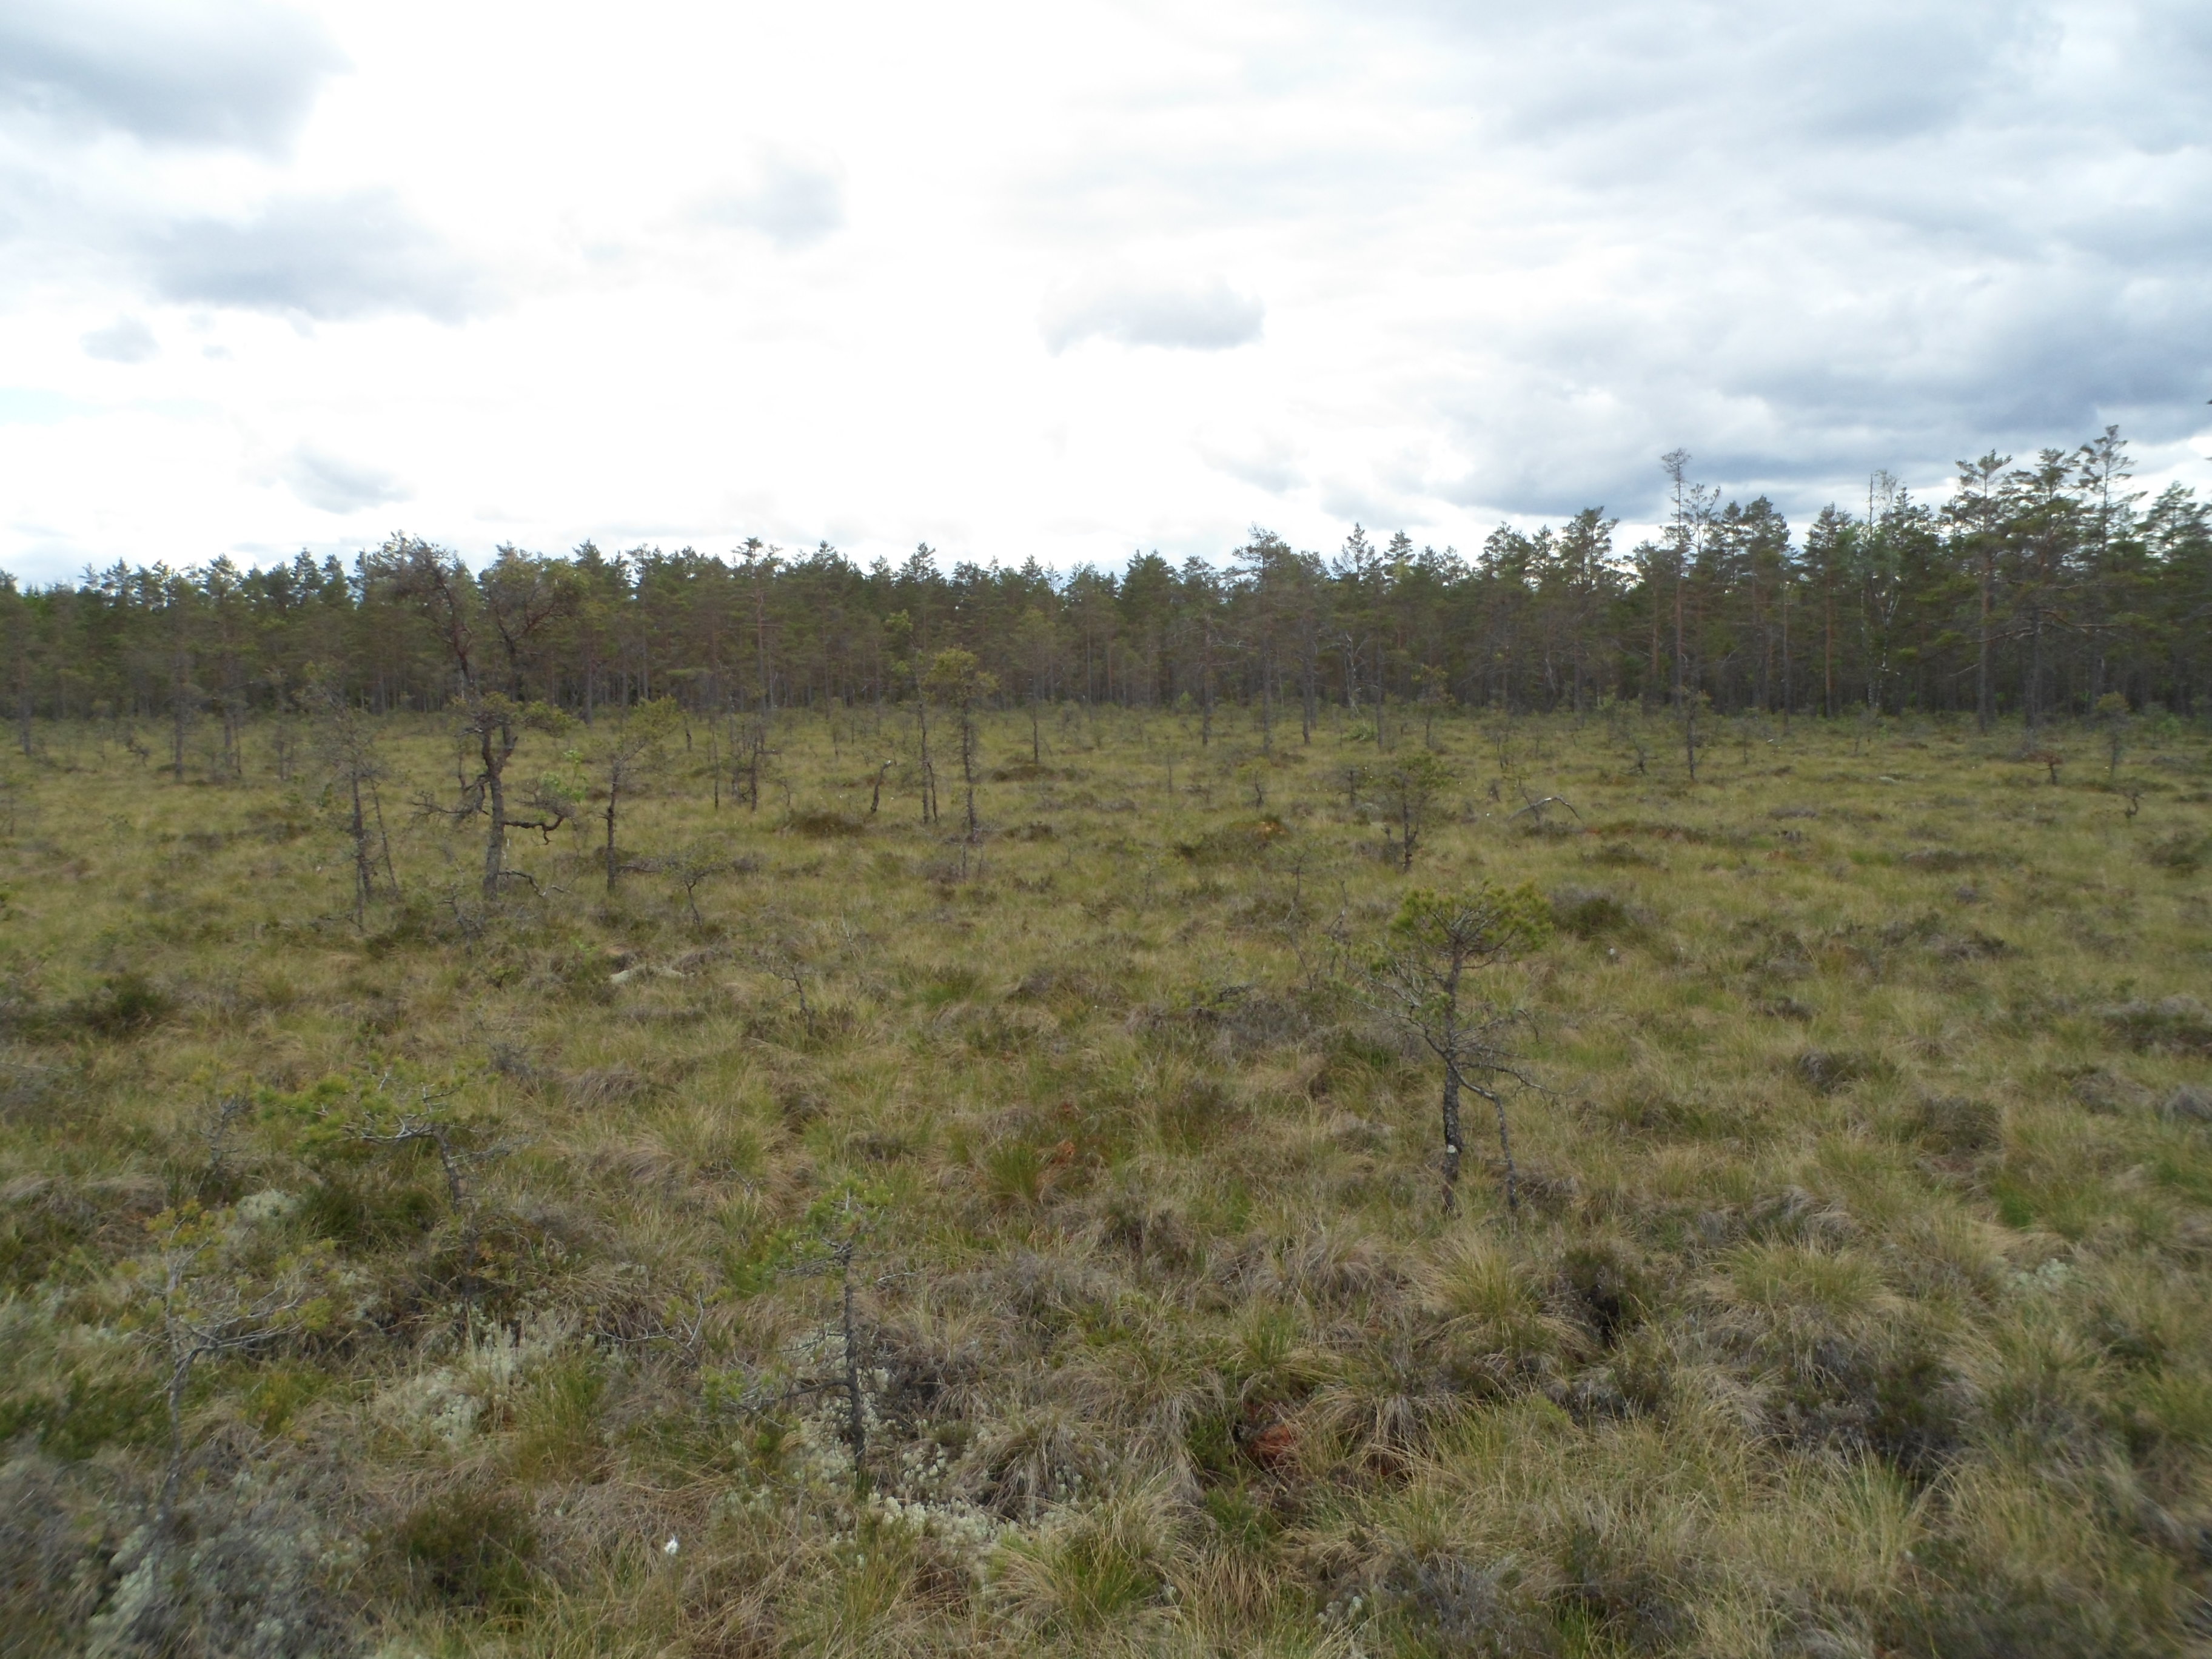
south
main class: Woodland
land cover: Pine dominated coniferous woodland
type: boreal forest
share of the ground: 10 - 25 %
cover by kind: herbaceous plants 40 %, lichens and mosses 35 %, coniferous forest trees 15 %, shrubs 10 %
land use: Amenities, museums, leisure
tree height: < 5 m
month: June
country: SE
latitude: 57.3908
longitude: 14.4048
